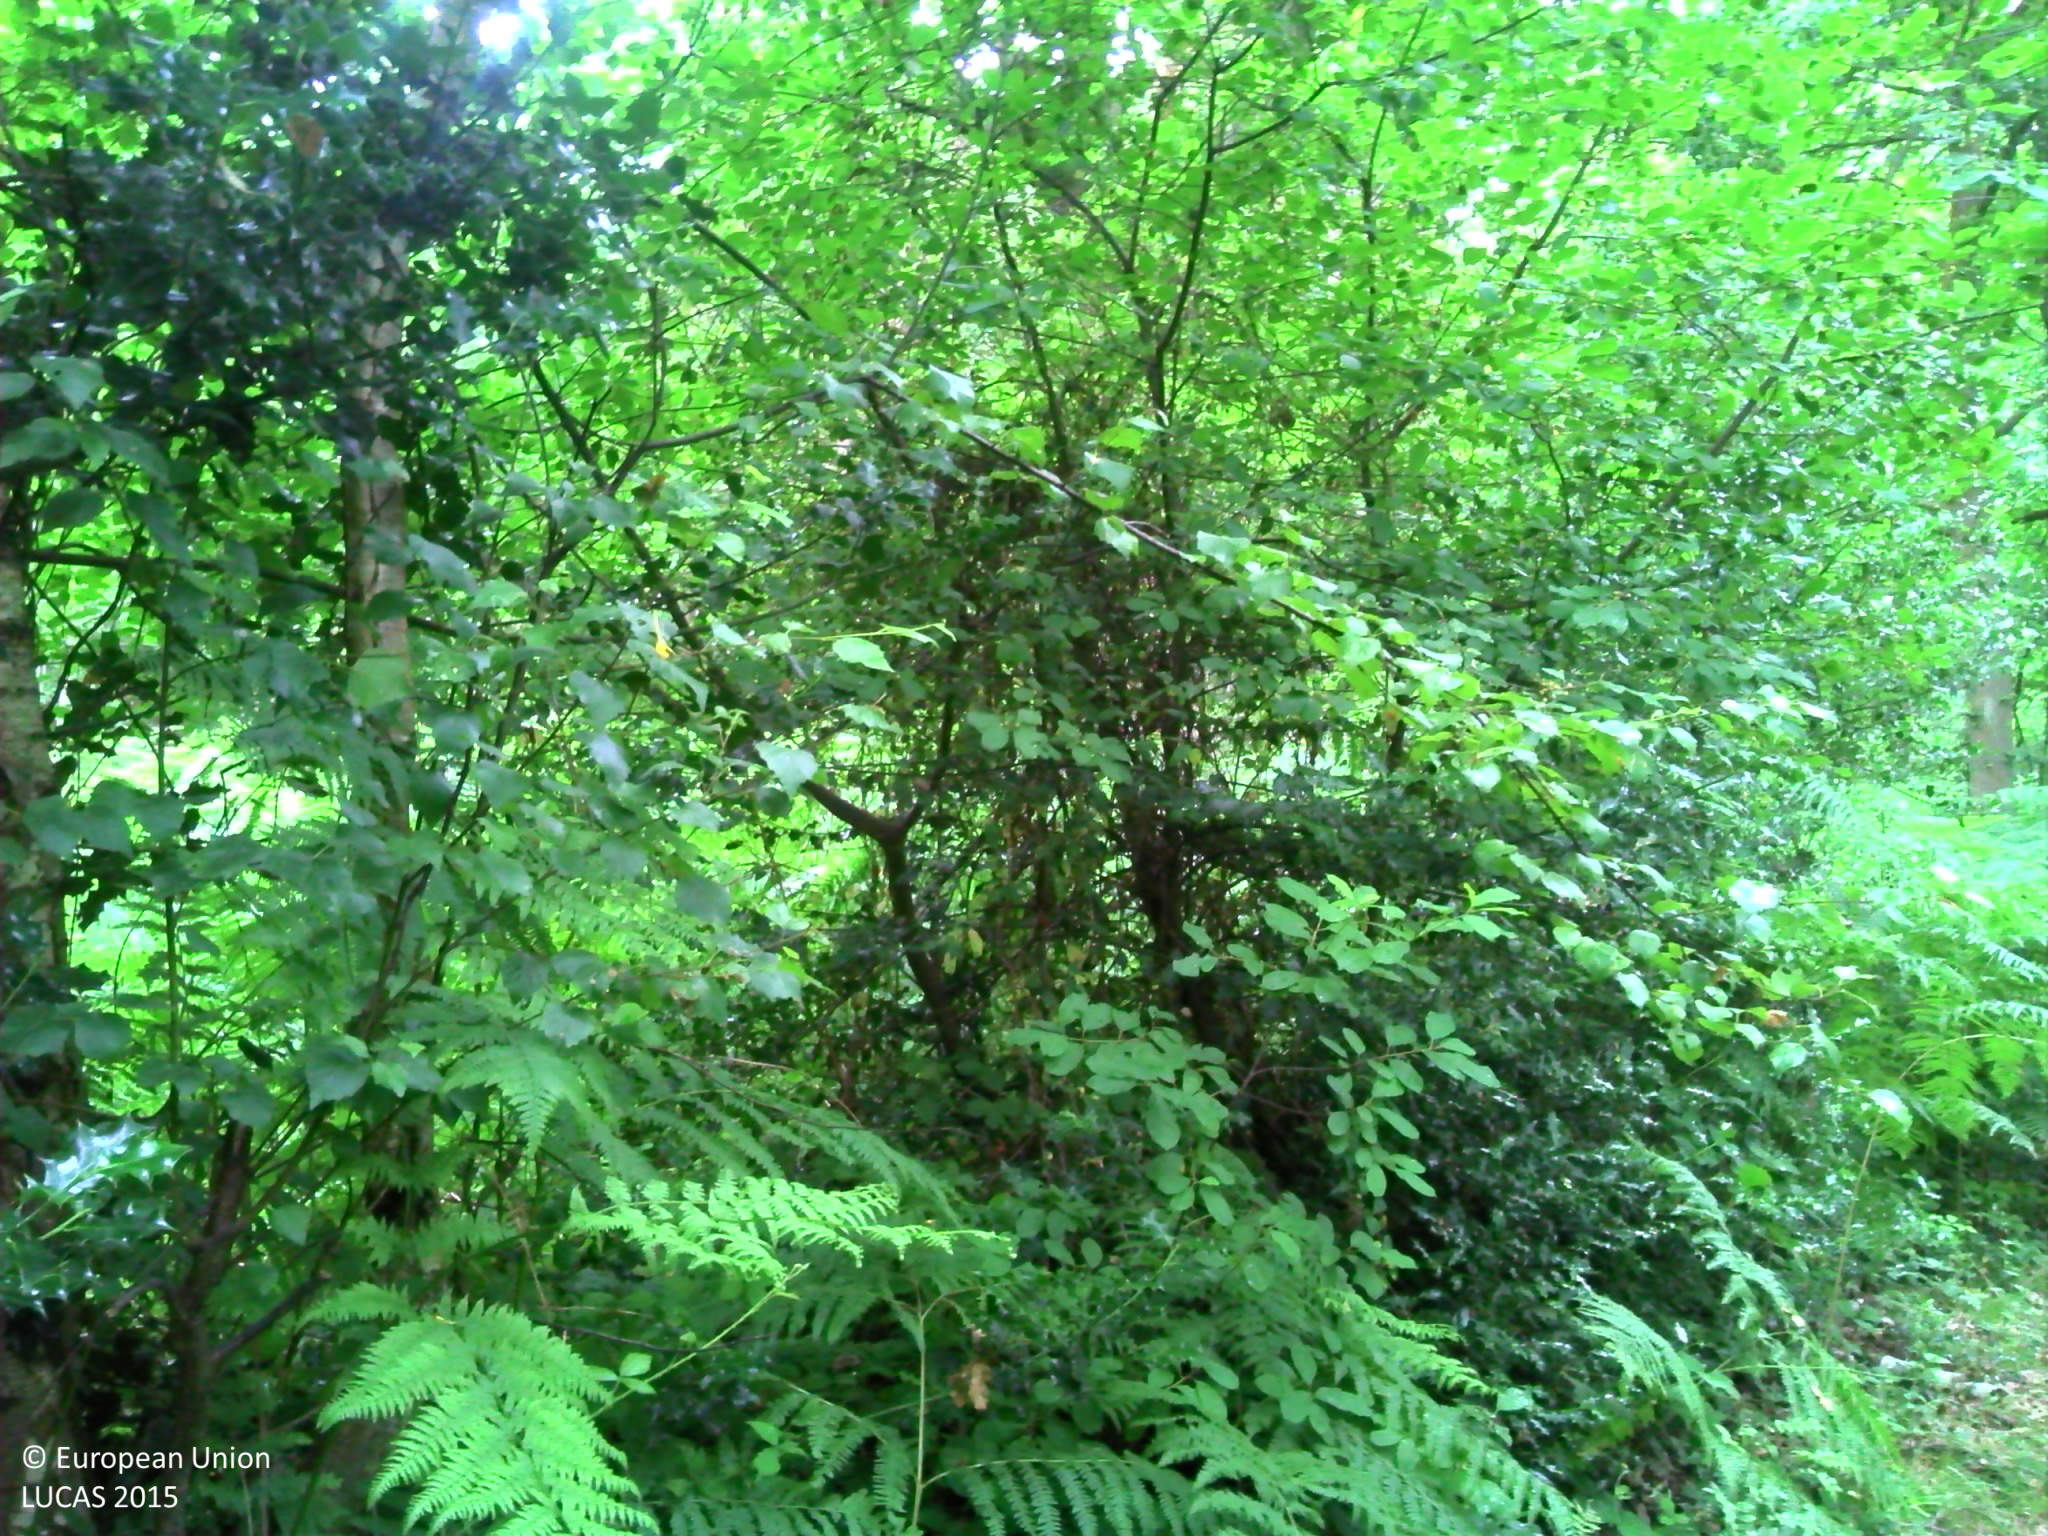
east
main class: Woodland
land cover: Pine dominated mixed woodland
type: mesophytic deciduous forest
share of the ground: > 75 %
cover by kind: broadleaved forest trees 50 %, coniferous forest trees 20 %, herbaceous plants 20 %, consolidated bare surface 10 %
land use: Forestry
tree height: > 5 m
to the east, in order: Pine dominated mixed woodland; Broadleaved woodland
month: July
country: FR
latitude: 49.2224
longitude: 0.6800
